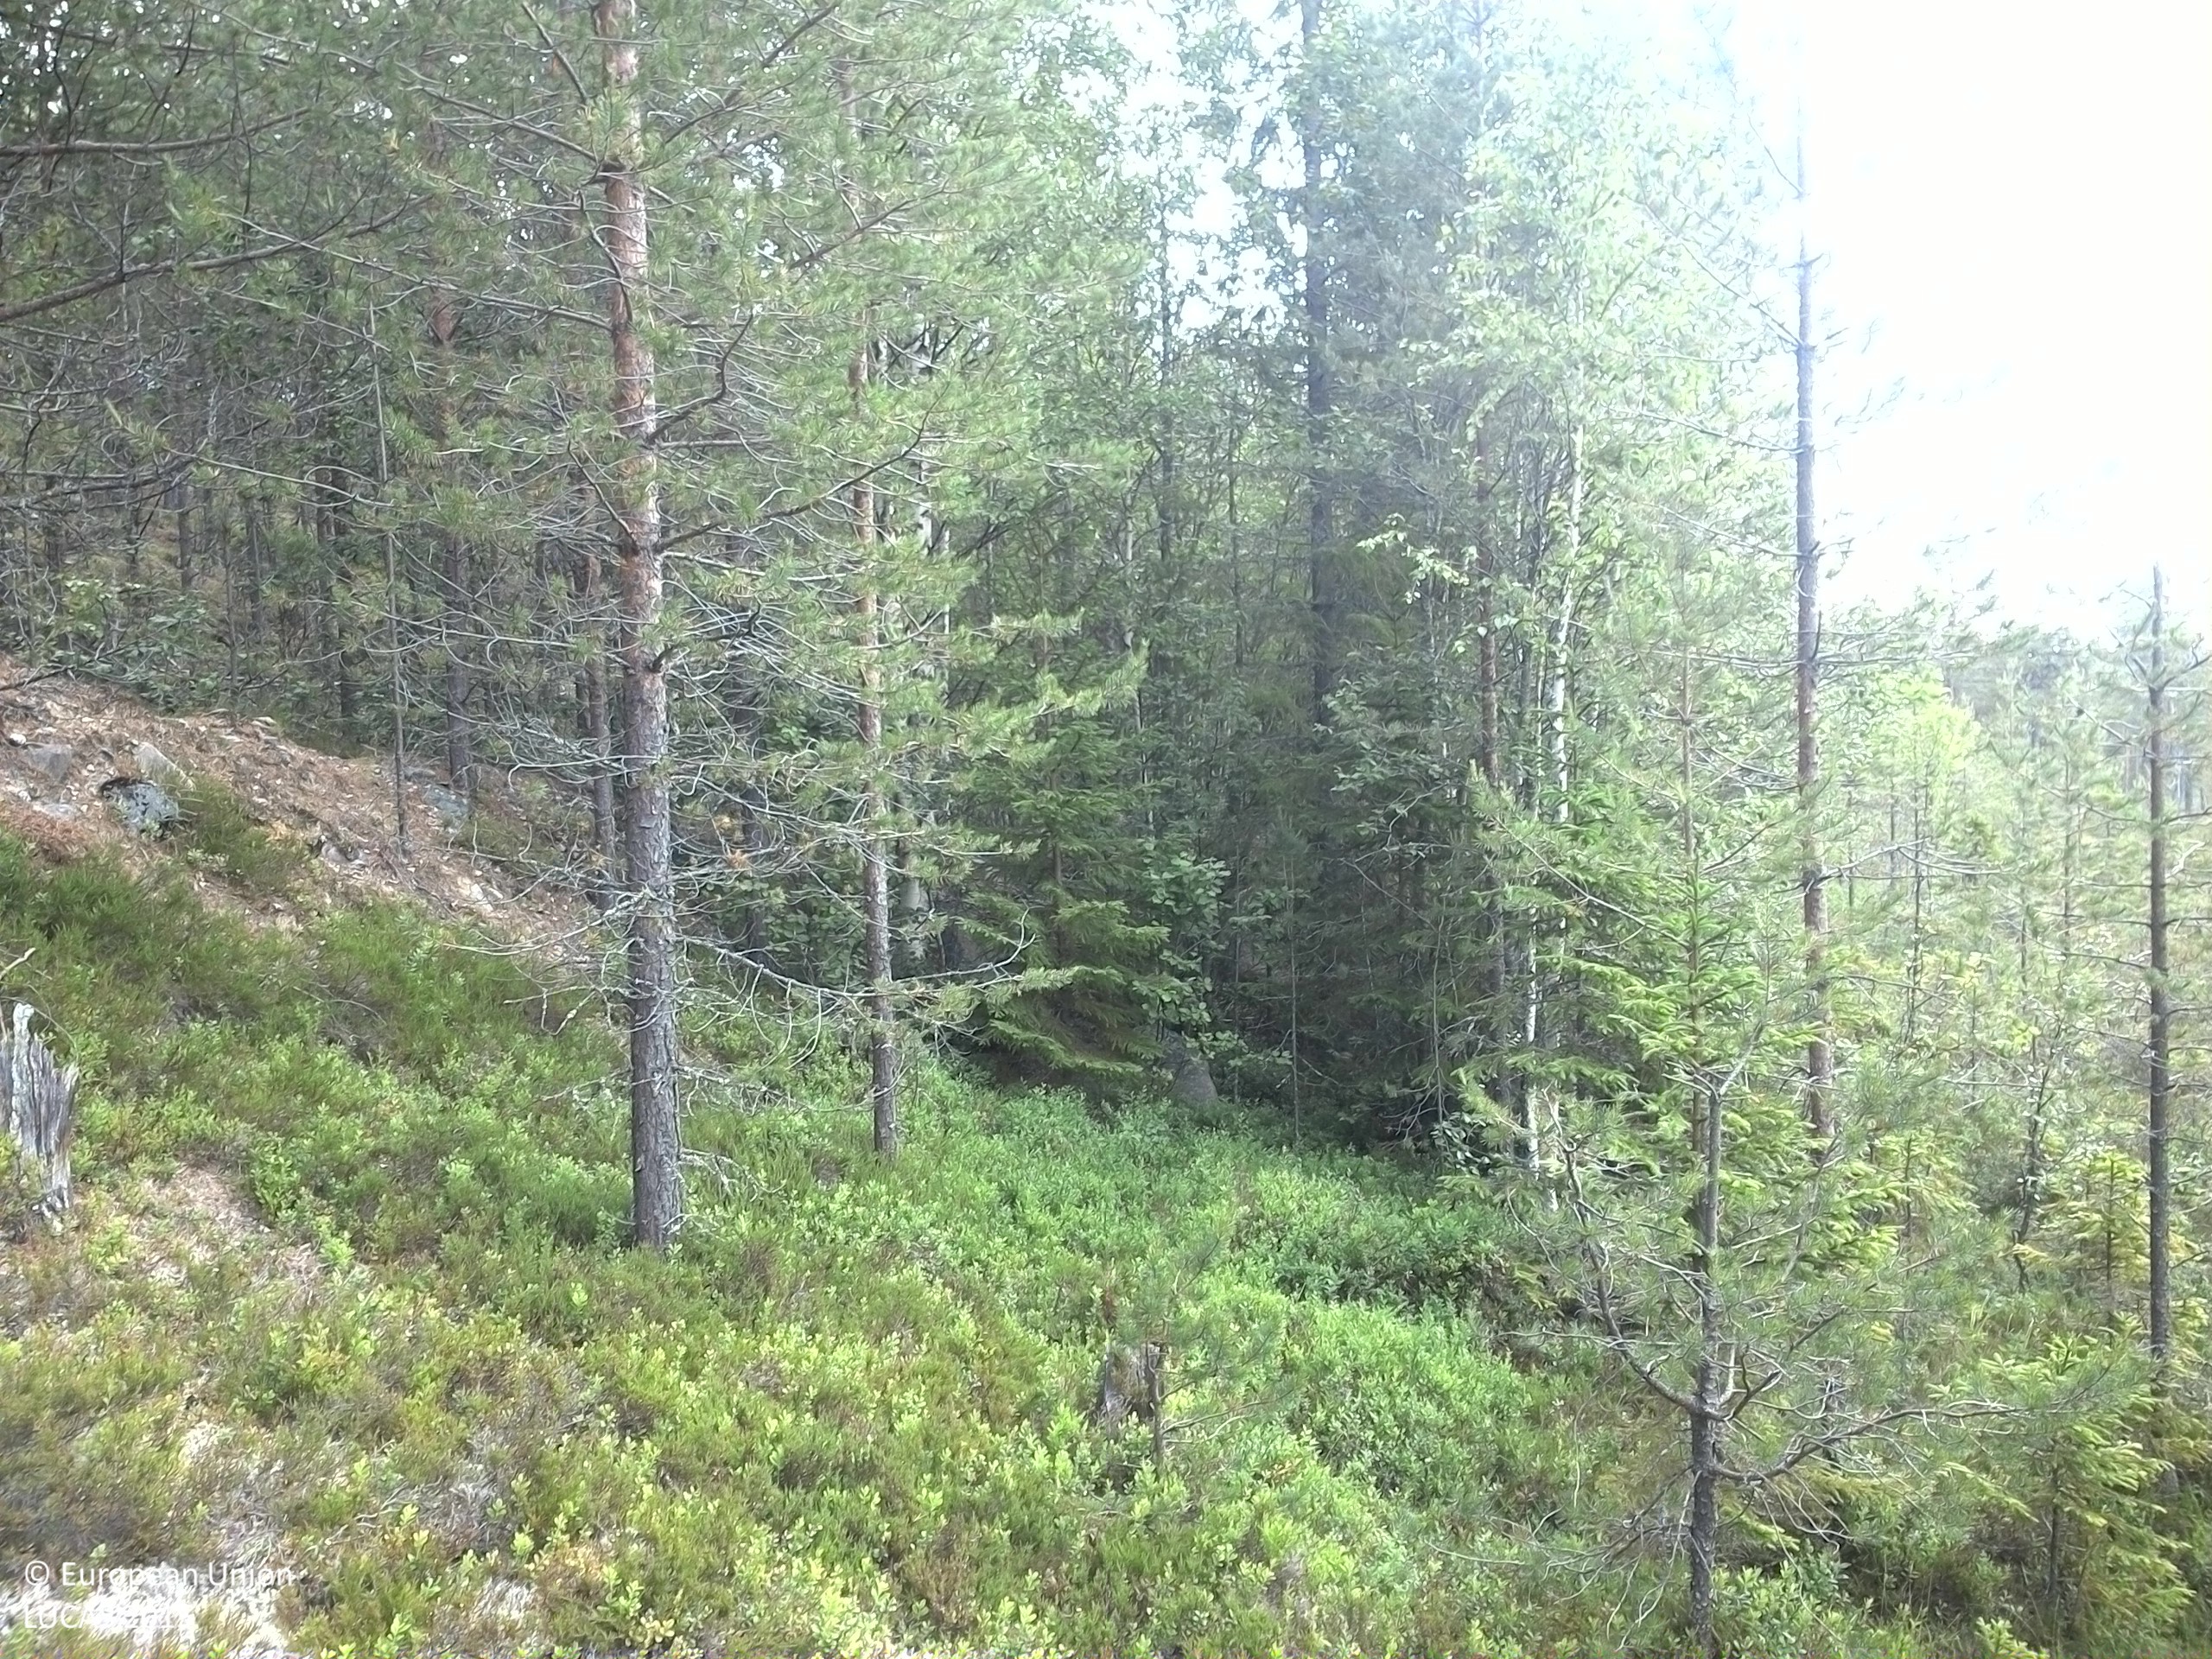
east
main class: Woodland
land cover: Pine dominated coniferous woodland
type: boreal forest
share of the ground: 50 - 75 %
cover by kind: coniferous forest trees 45 %, shrubs 25 %, lichens and mosses 25 %, broadleaved forest trees 5 %
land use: Forestry
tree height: > 5 m
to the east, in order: Pine dominated coniferous woodland; Pine dominated mixed woodland; Pine dominated coniferous woodland
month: July
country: SE
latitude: 63.5466
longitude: 17.5592
